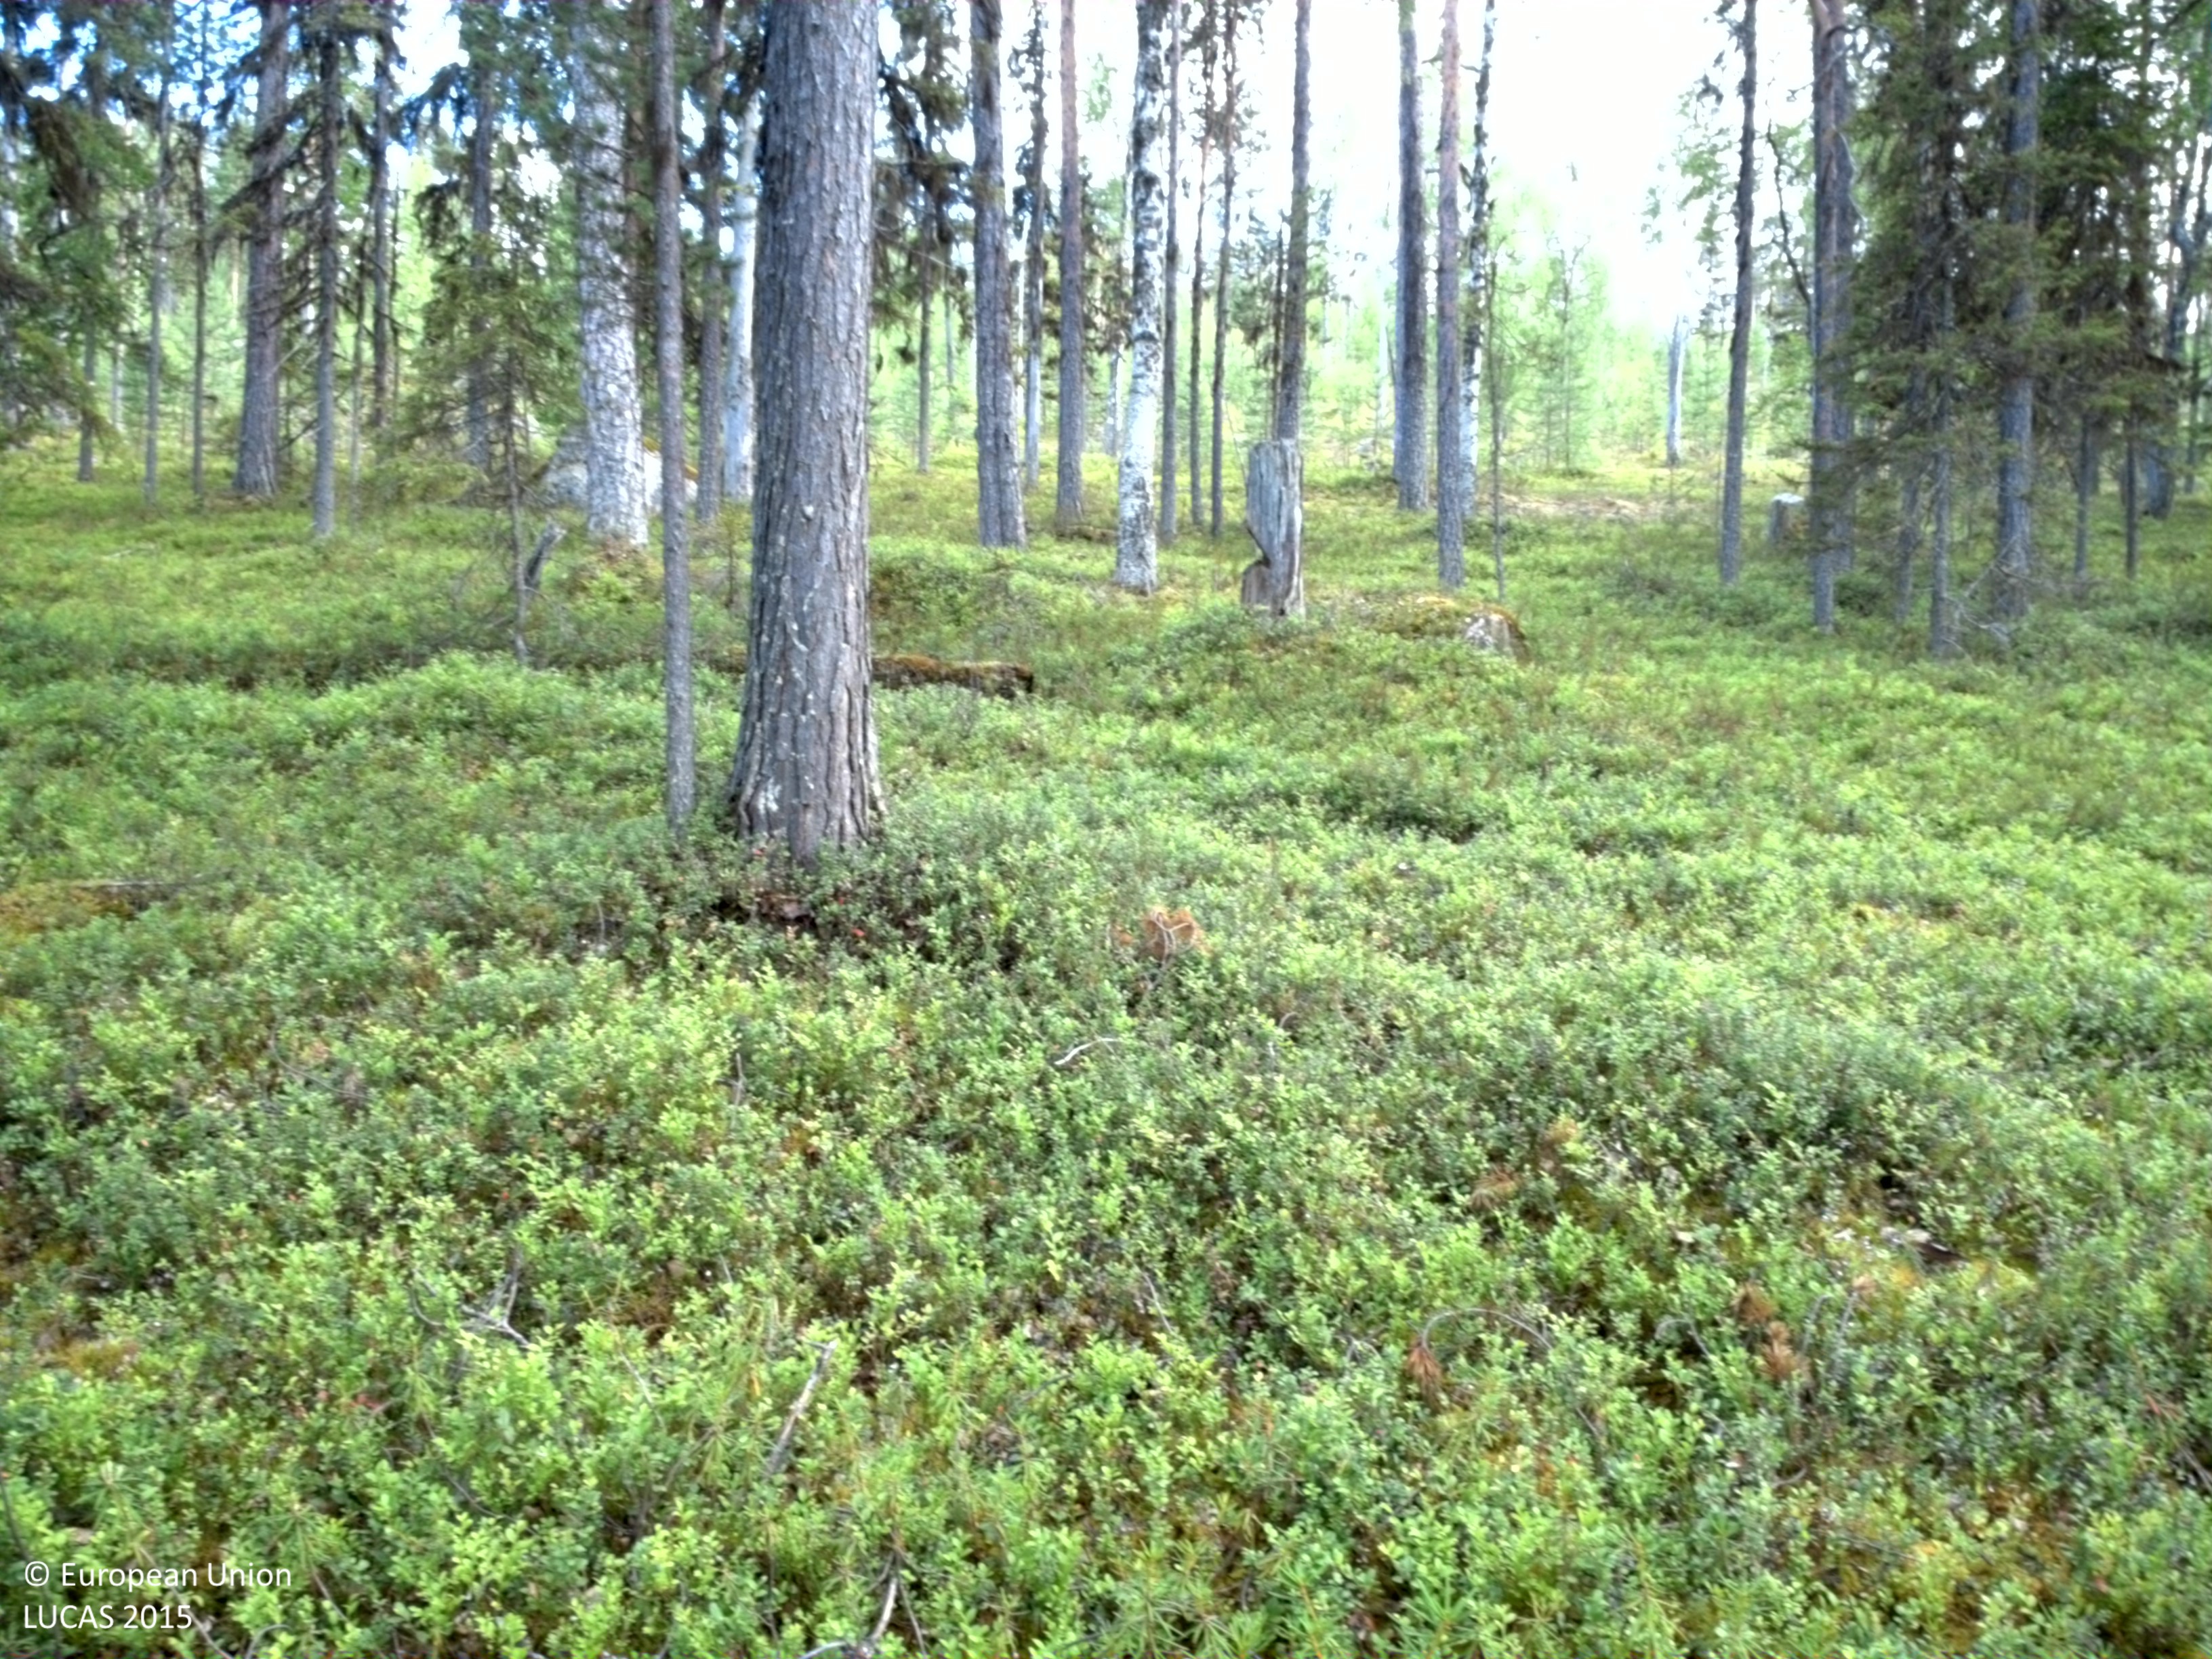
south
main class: Woodland
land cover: Pine dominated coniferous woodland
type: boreal forest
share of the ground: 25 - 50 %
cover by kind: shrubs 65 %, coniferous forest trees 30 %, broadleaved forest trees 5 %
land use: Forestry
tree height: > 5 m
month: August
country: SE
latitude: 66.5626
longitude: 20.0246
